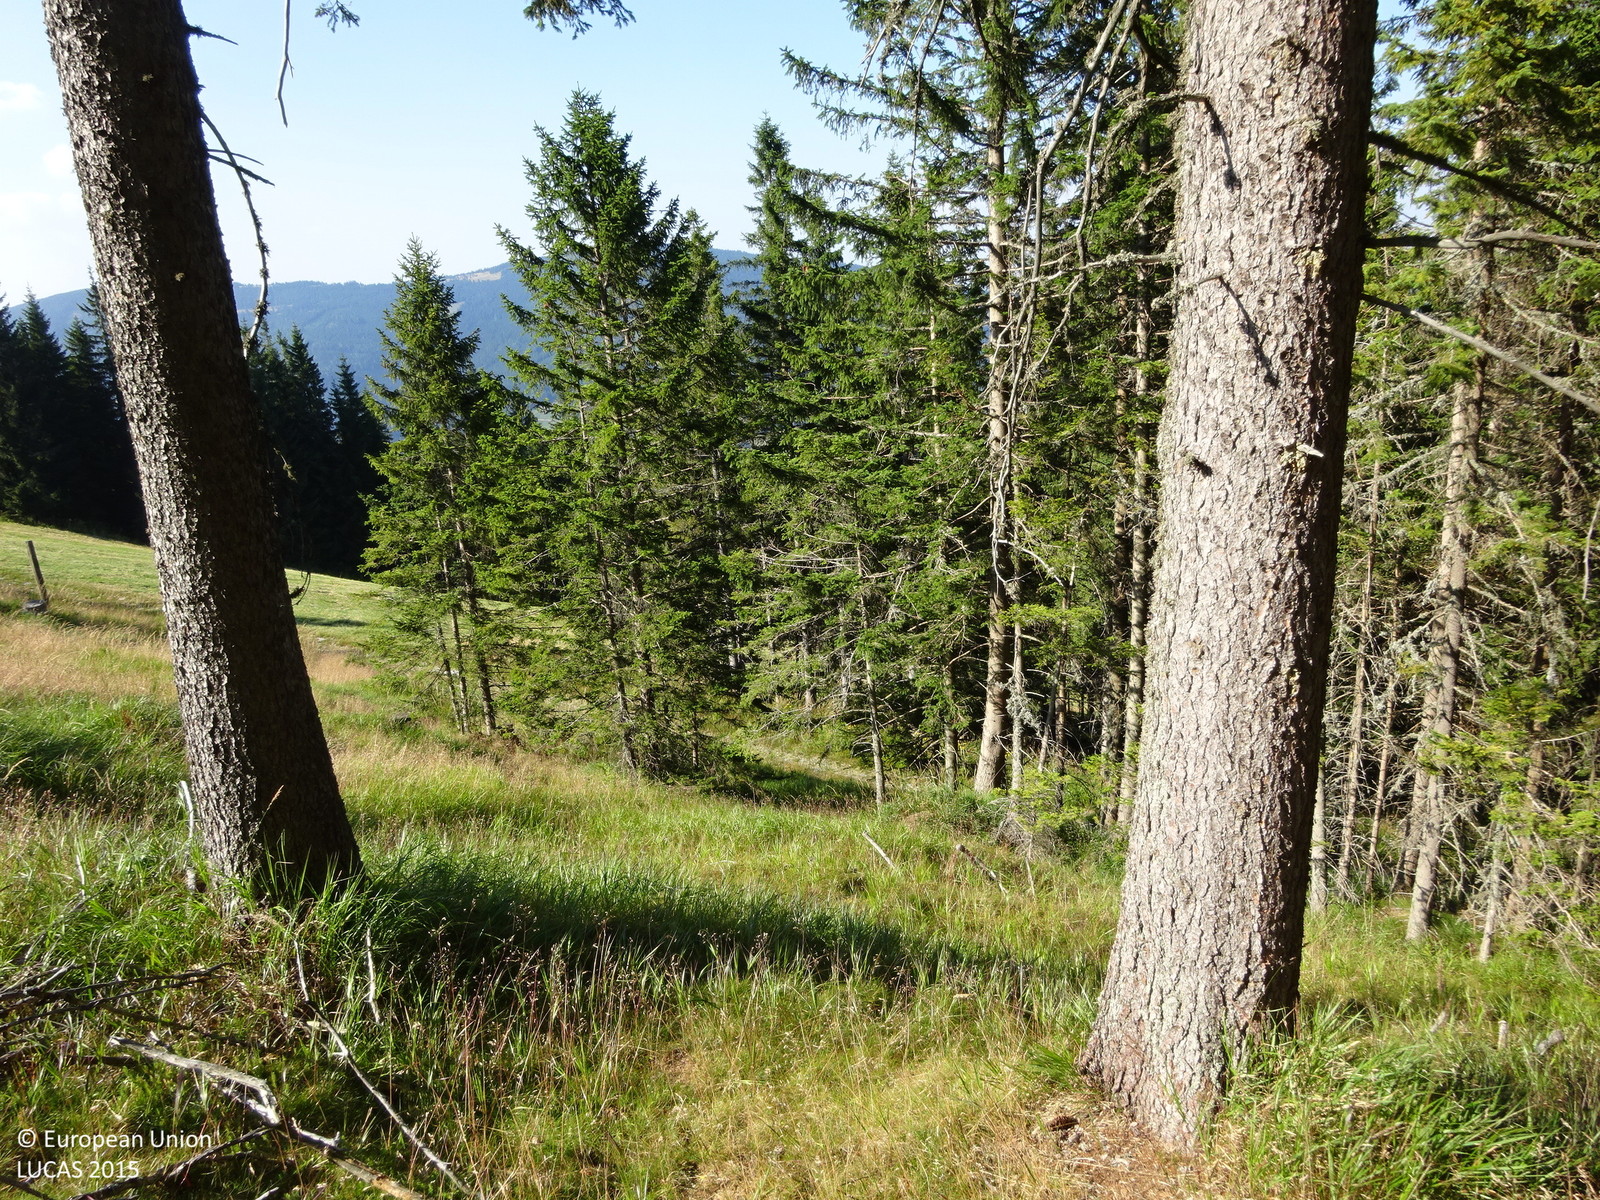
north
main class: Woodland
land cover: Spruce dominated coniferous woodland
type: alpine coniferous forest
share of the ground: > 75 %
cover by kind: coniferous forest trees 80 %, herbaceous plants 20 %
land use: Forestry
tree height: > 5 m
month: August
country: AT
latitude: 47.5192
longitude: 15.9915
